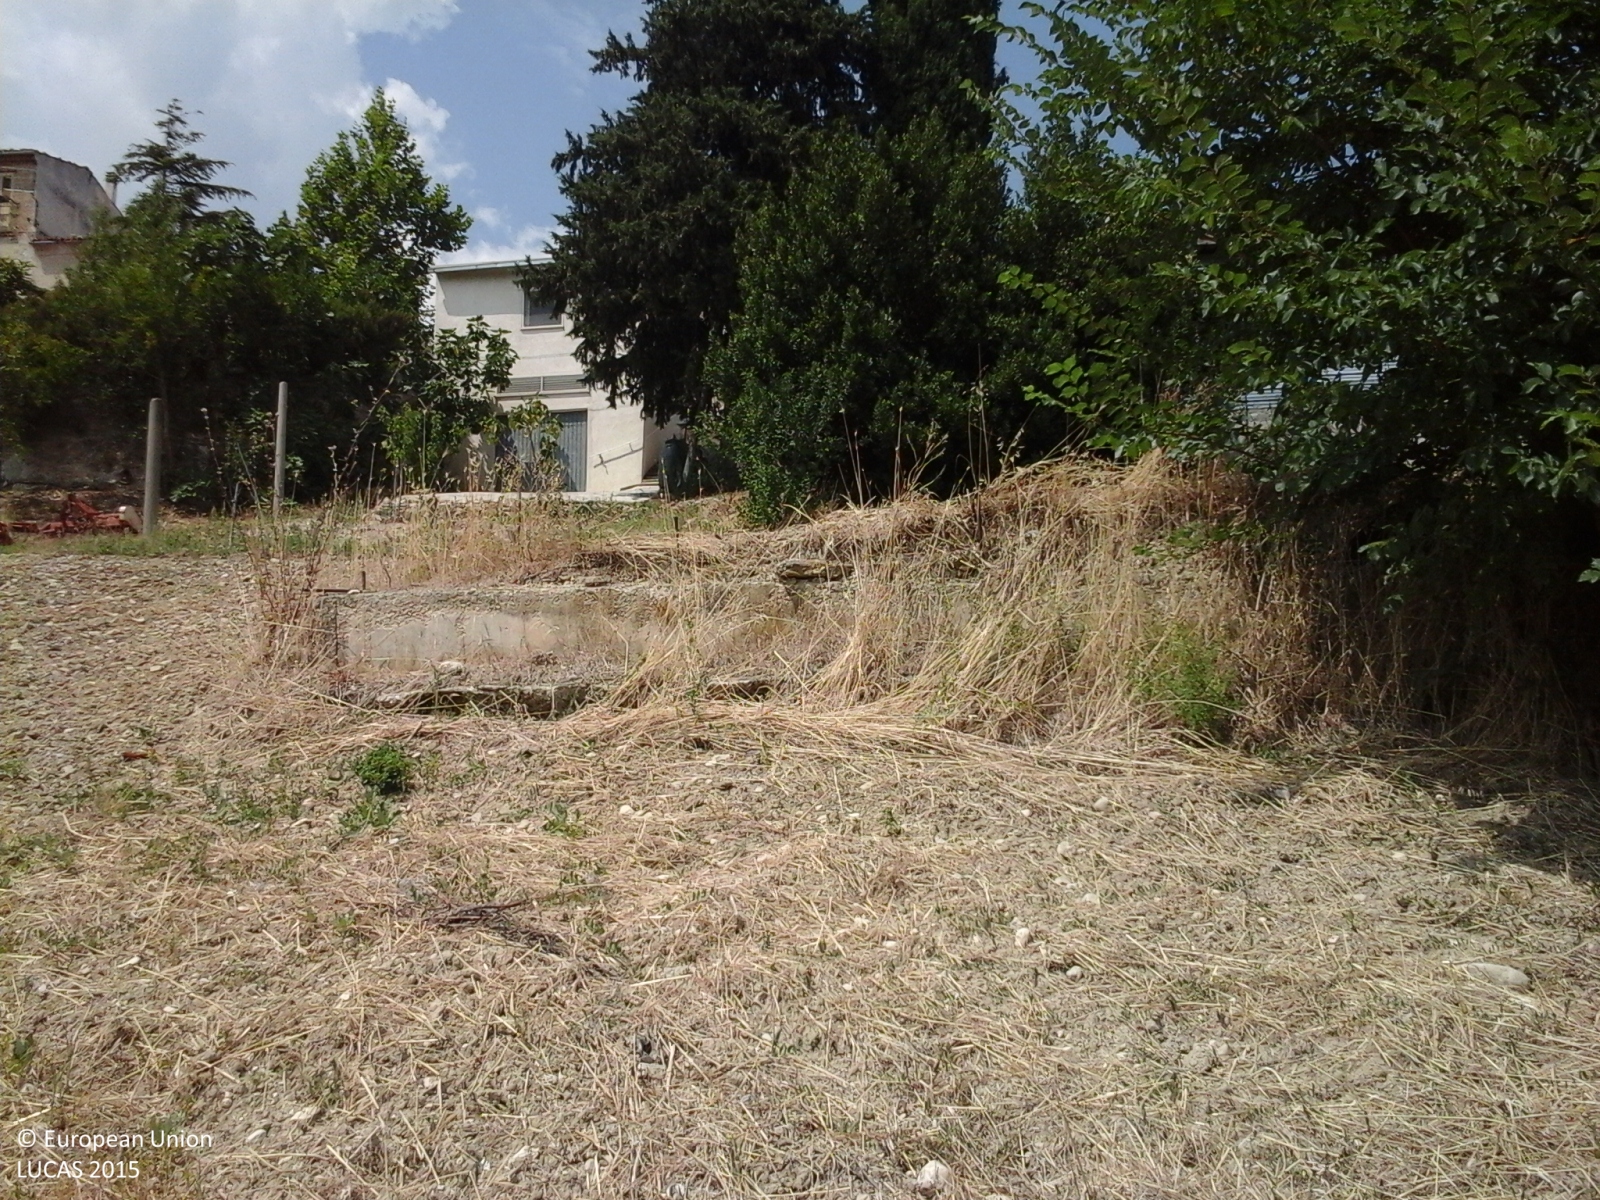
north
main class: Grassland
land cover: Spontaneously vegetated surfaces
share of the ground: > 75 %
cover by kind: herbaceous plants 100 %
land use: Agriculture (excluding fallow land and kitchen gardens)
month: July
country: IT
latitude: 42.2353
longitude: 13.9015
